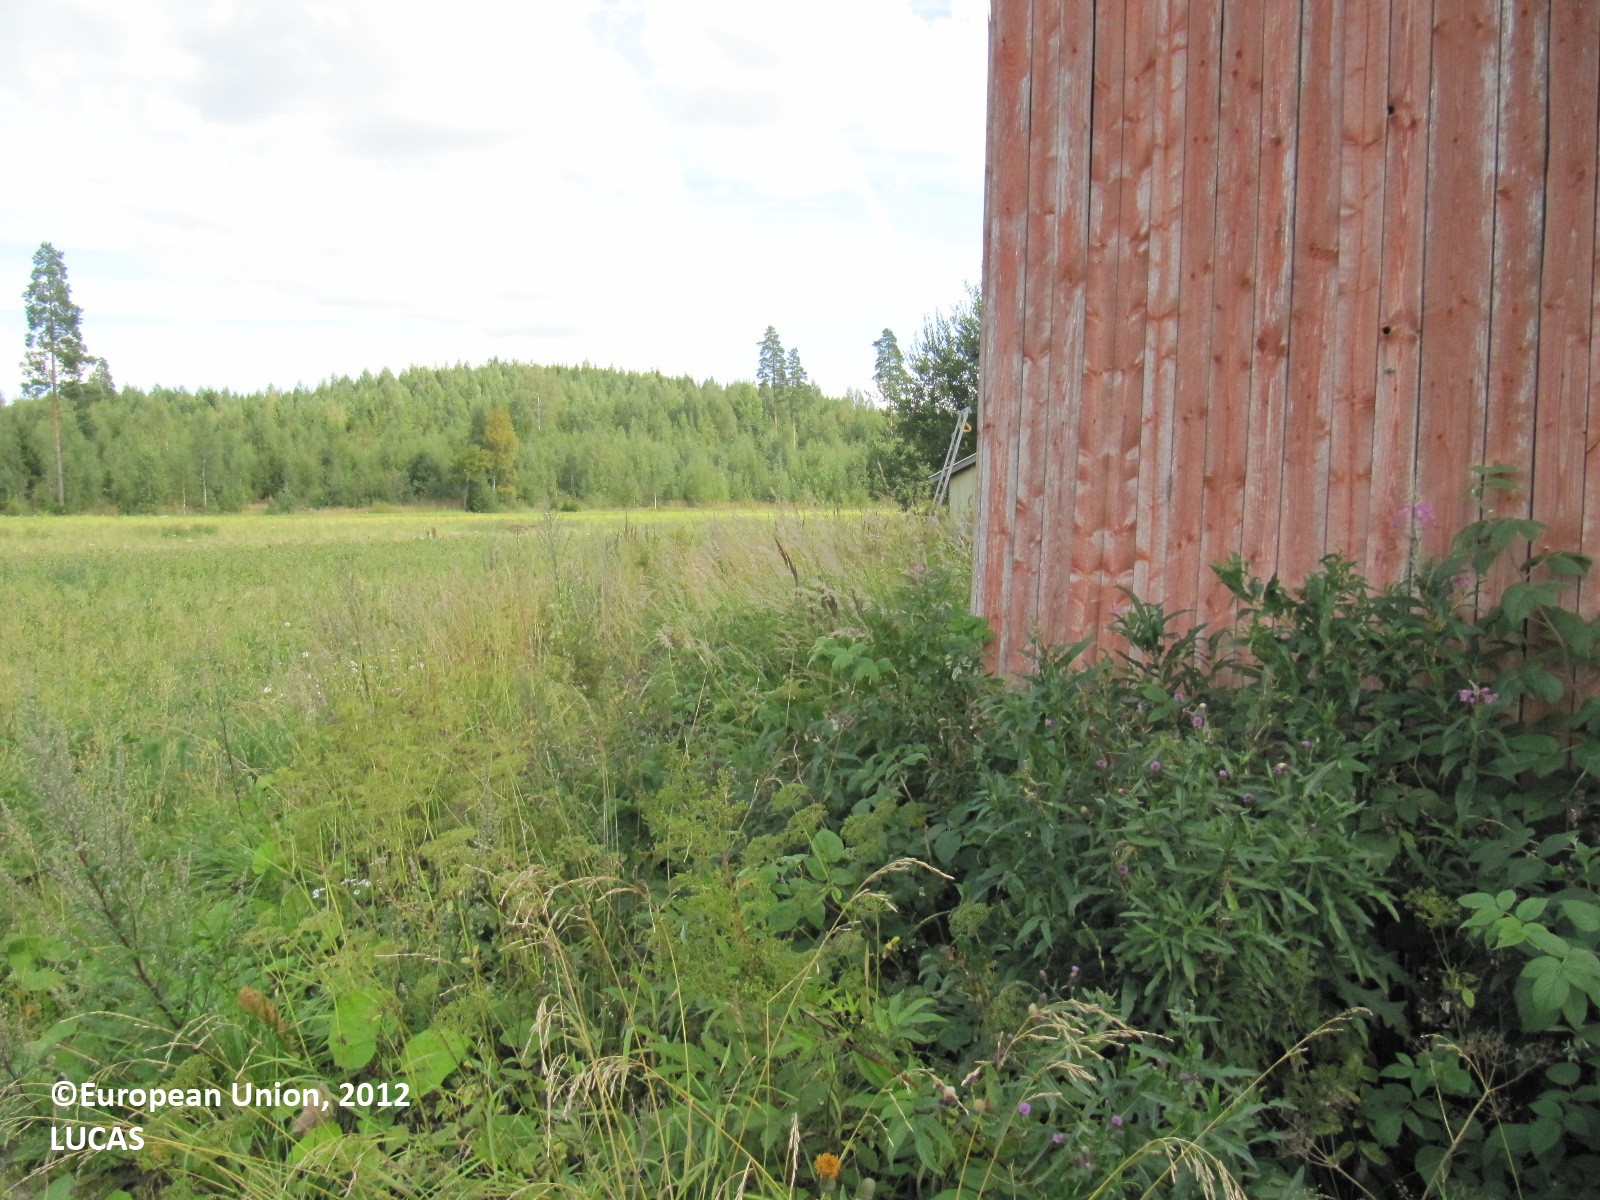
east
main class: Cropland
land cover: Dry pulses
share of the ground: > 75 %
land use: Agriculture (excluding fallow land and kitchen gardens)
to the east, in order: Dry pulses; Ditches and canals; Other mixed woodland
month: August
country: FI
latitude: 60.3919
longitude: 24.3849
